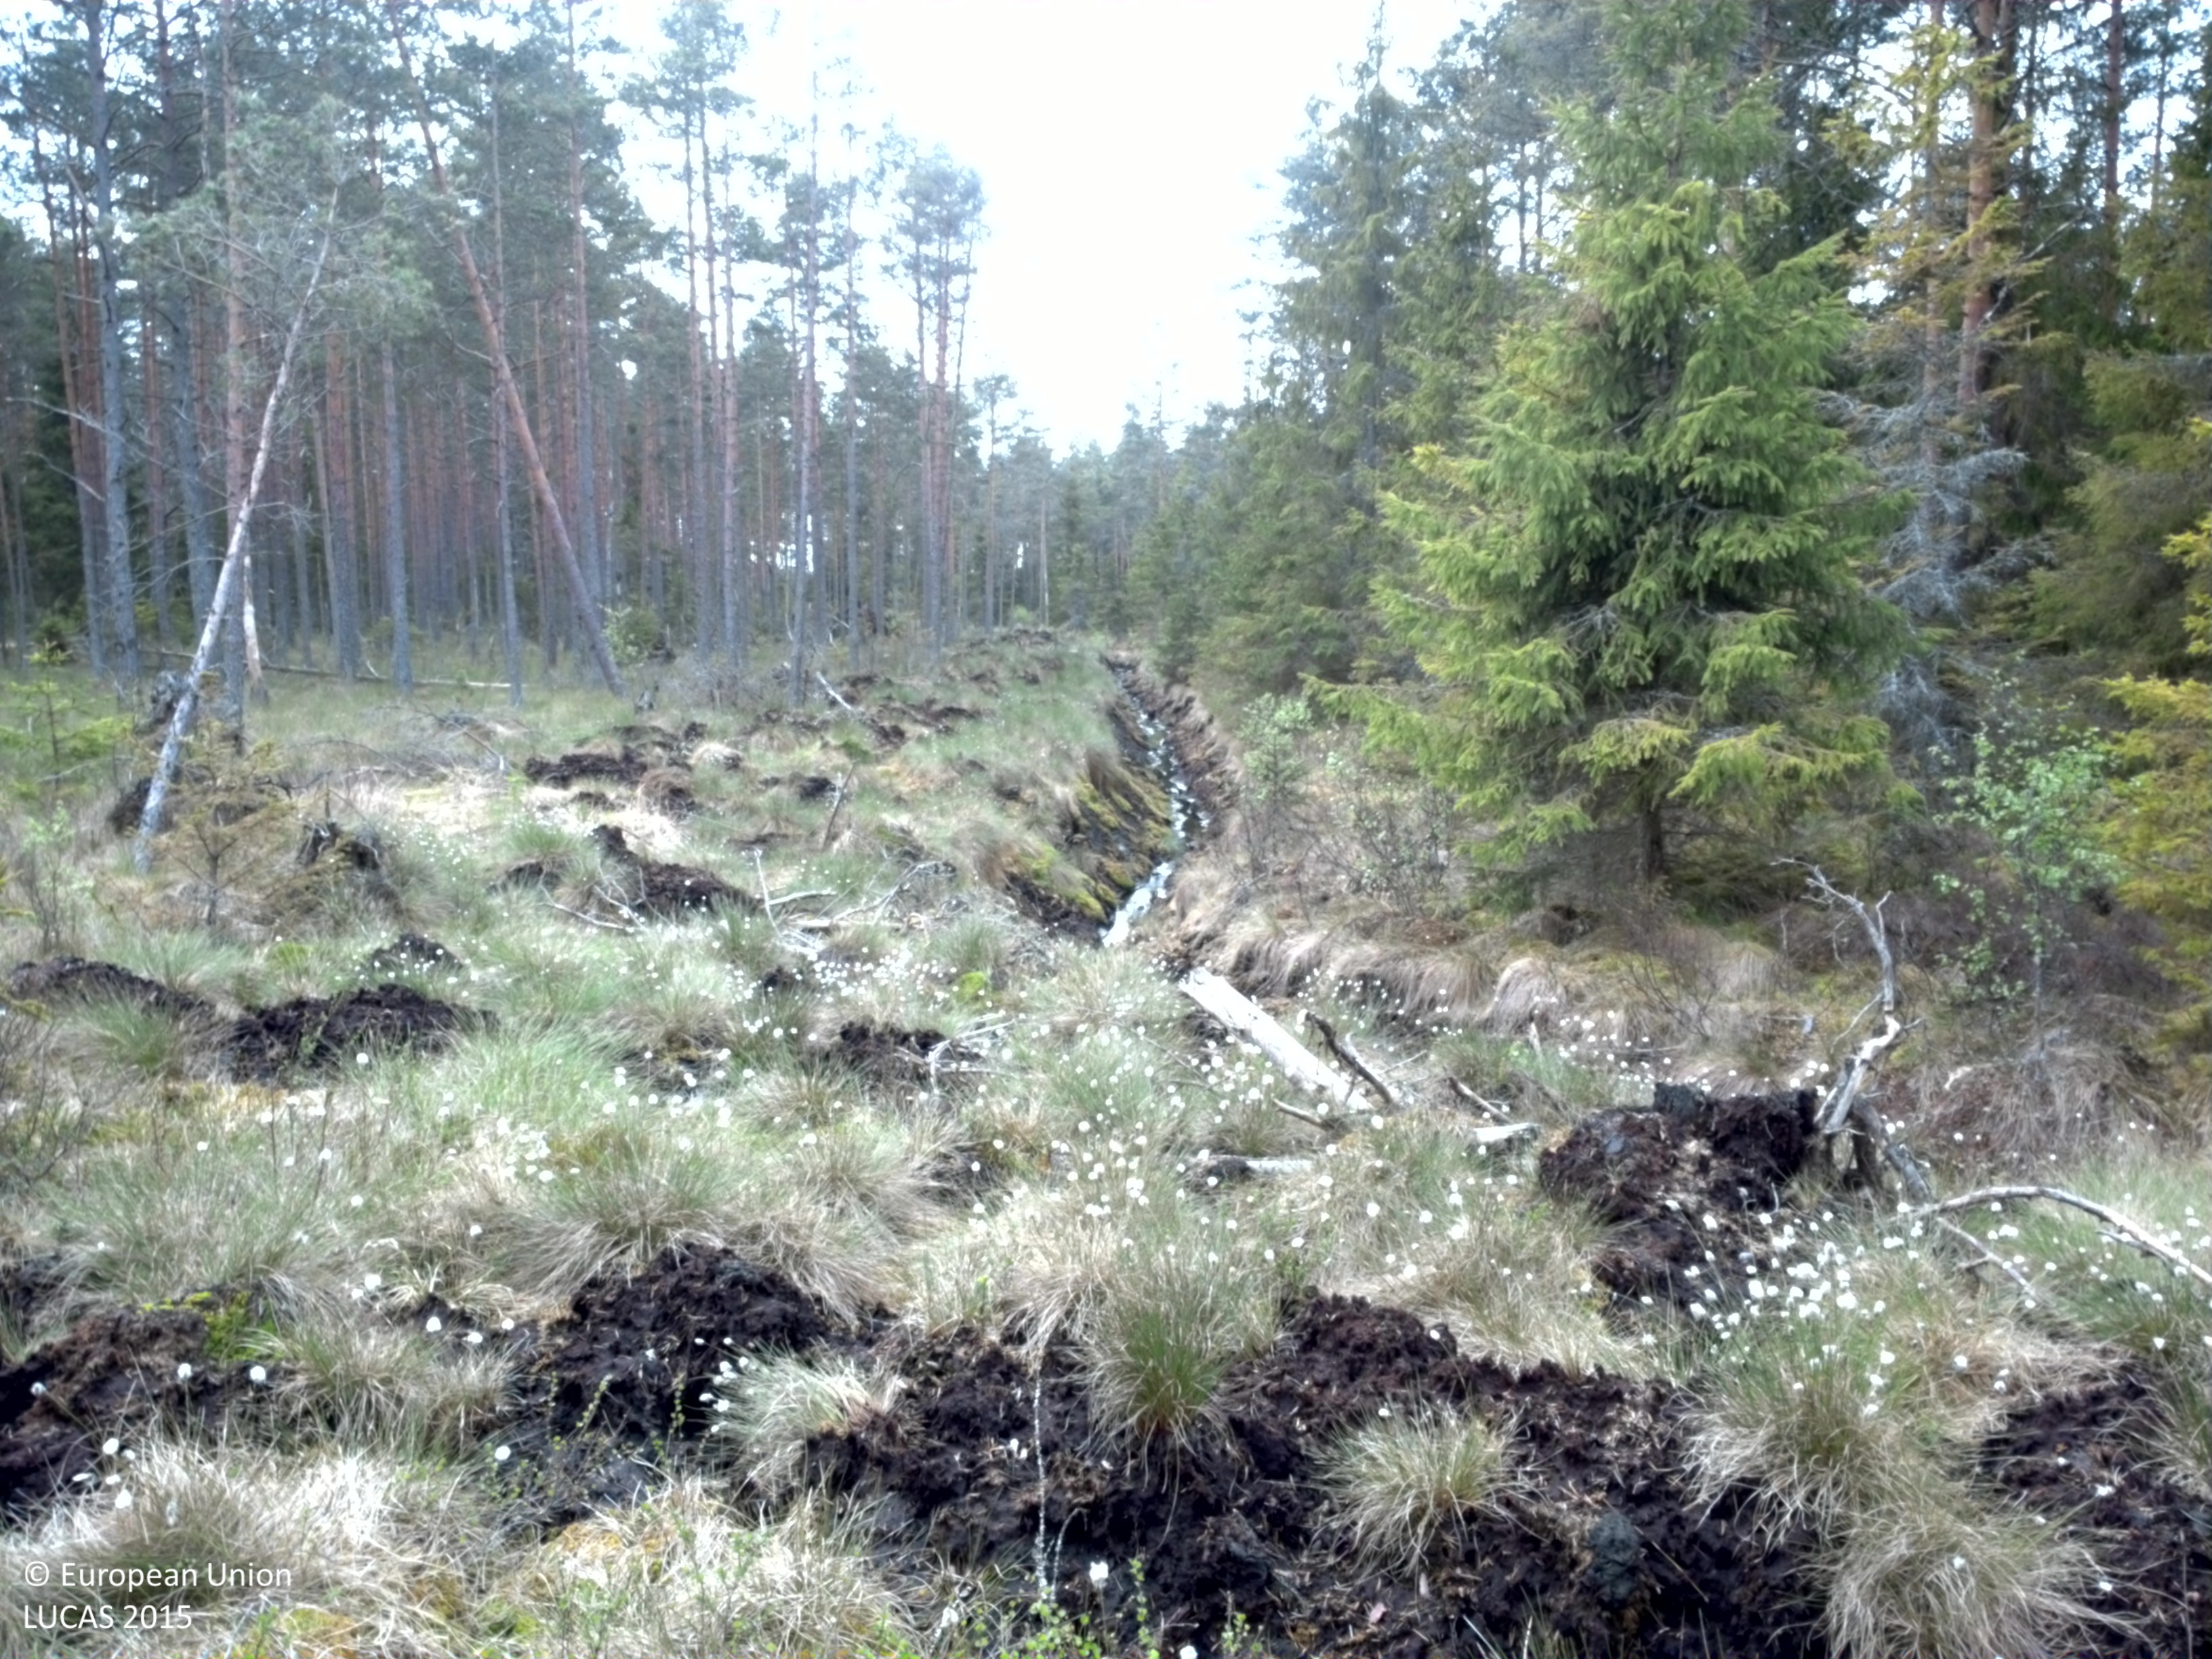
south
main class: Woodland
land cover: Pine dominated coniferous woodland
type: boreal forest
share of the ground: 50 - 75 %
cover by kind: coniferous forest trees 60 %, lichens and mosses 30 %, broadleaved forest trees 10 %
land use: Forestry
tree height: > 5 m
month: May
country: SE
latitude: 56.8574
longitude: 15.1965
